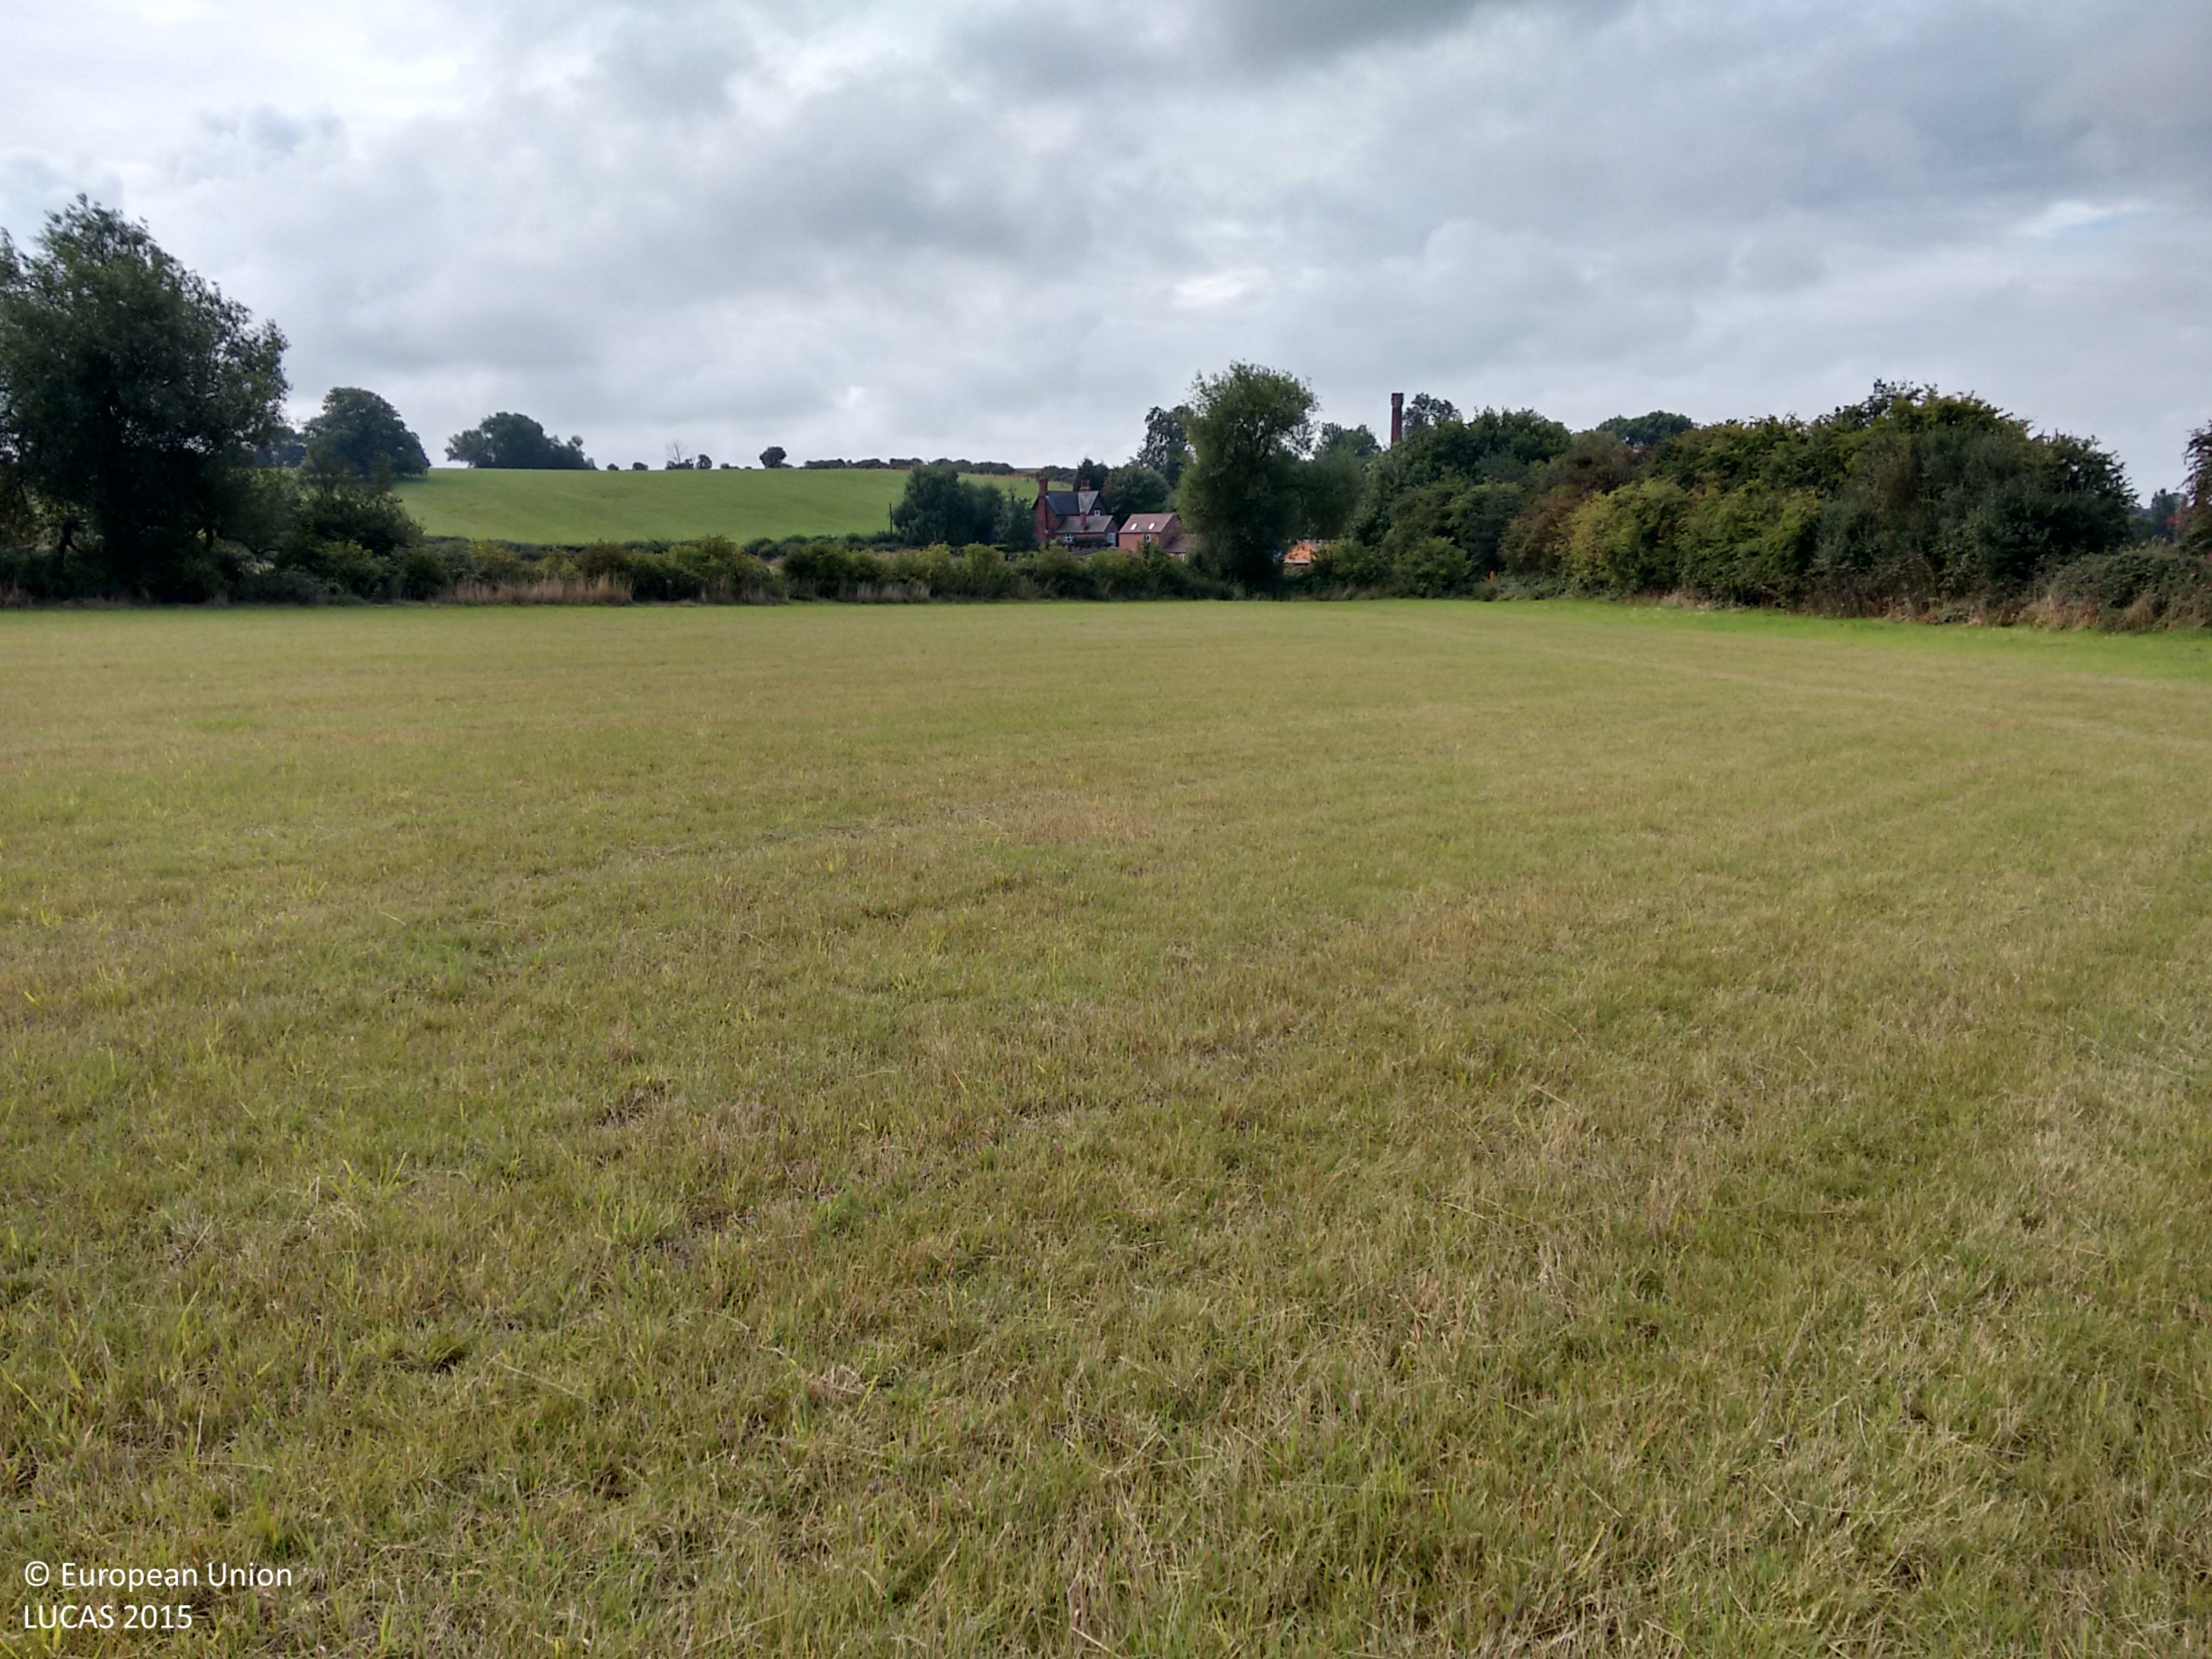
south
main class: Grassland
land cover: Grassland without tree/shrub cover
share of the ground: > 75 %
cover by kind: herbaceous plants 100 %
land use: Agriculture (excluding fallow land and kitchen gardens)
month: September
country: GB
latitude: 52.6897
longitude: -1.4869
